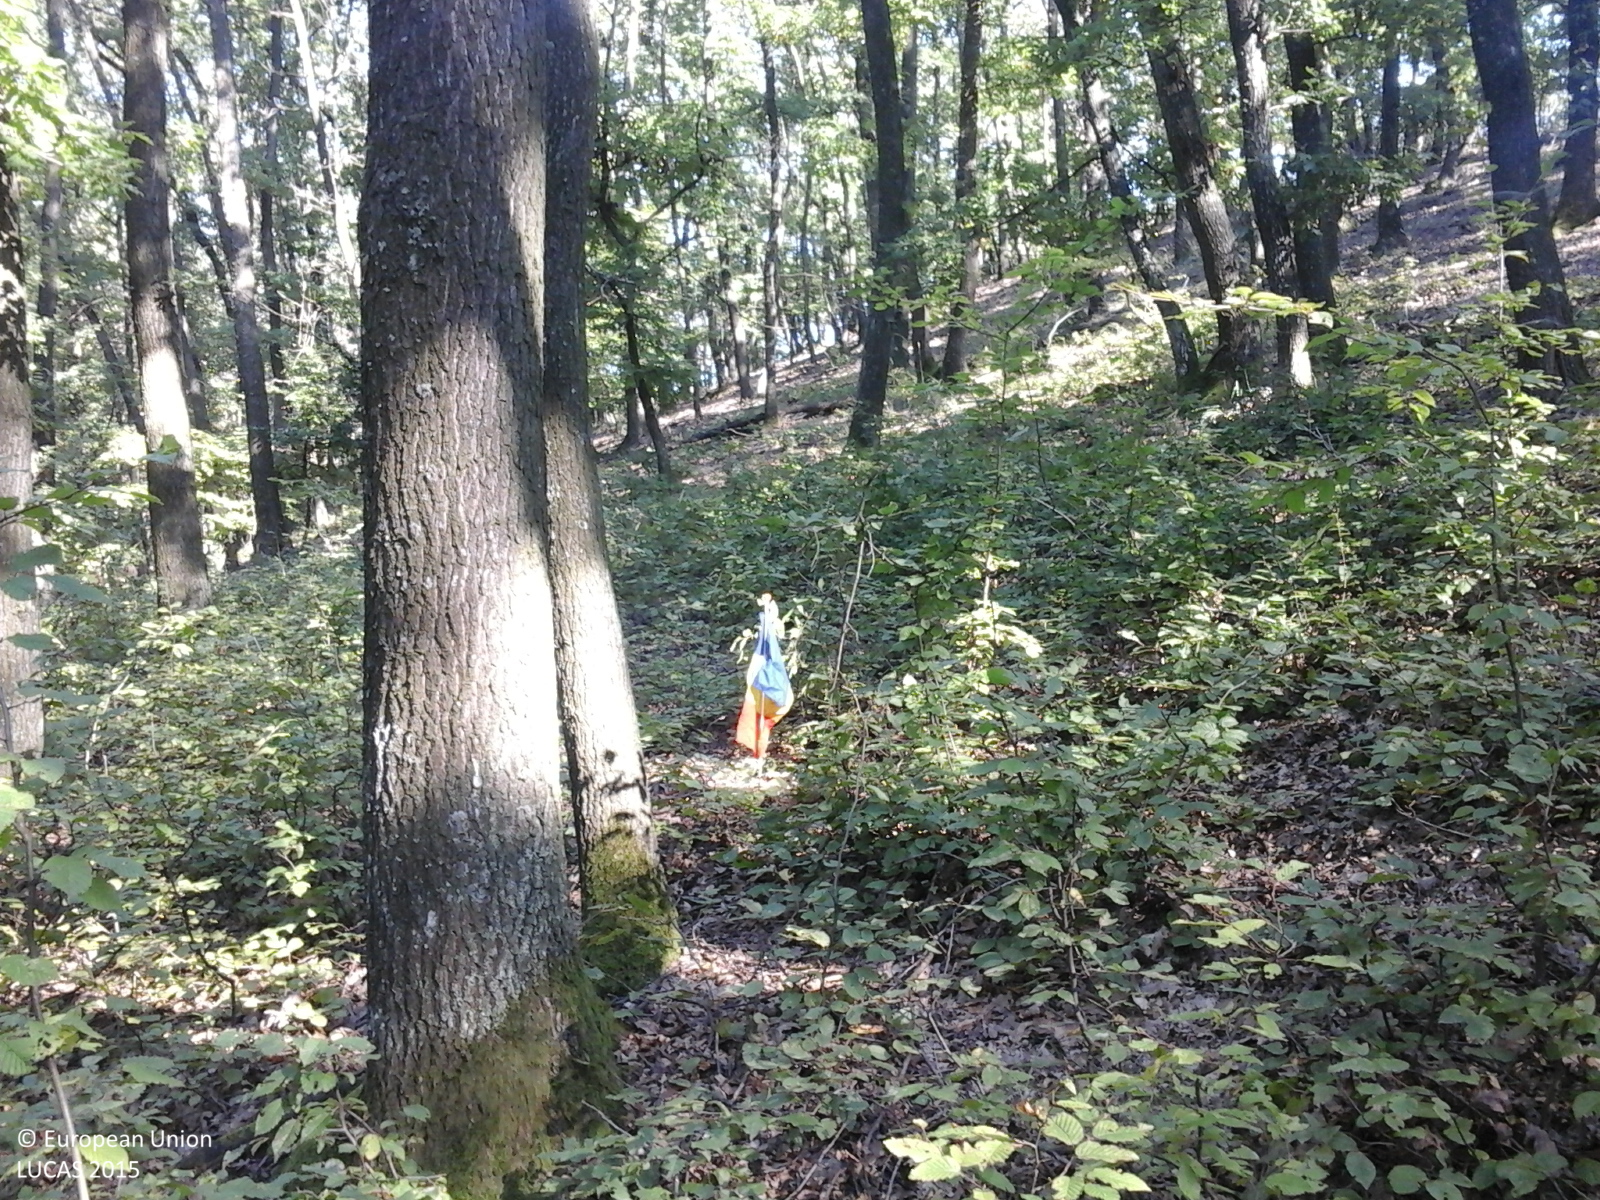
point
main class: Woodland
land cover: Broadleaved woodland
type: acidophilous oak and oak-birch forest
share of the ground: > 75 %
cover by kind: broadleaved forest trees 90 %, herbaceous plants 10 %
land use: Forestry
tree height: > 5 m
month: October
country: RO
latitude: 46.3069
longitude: 23.8227
